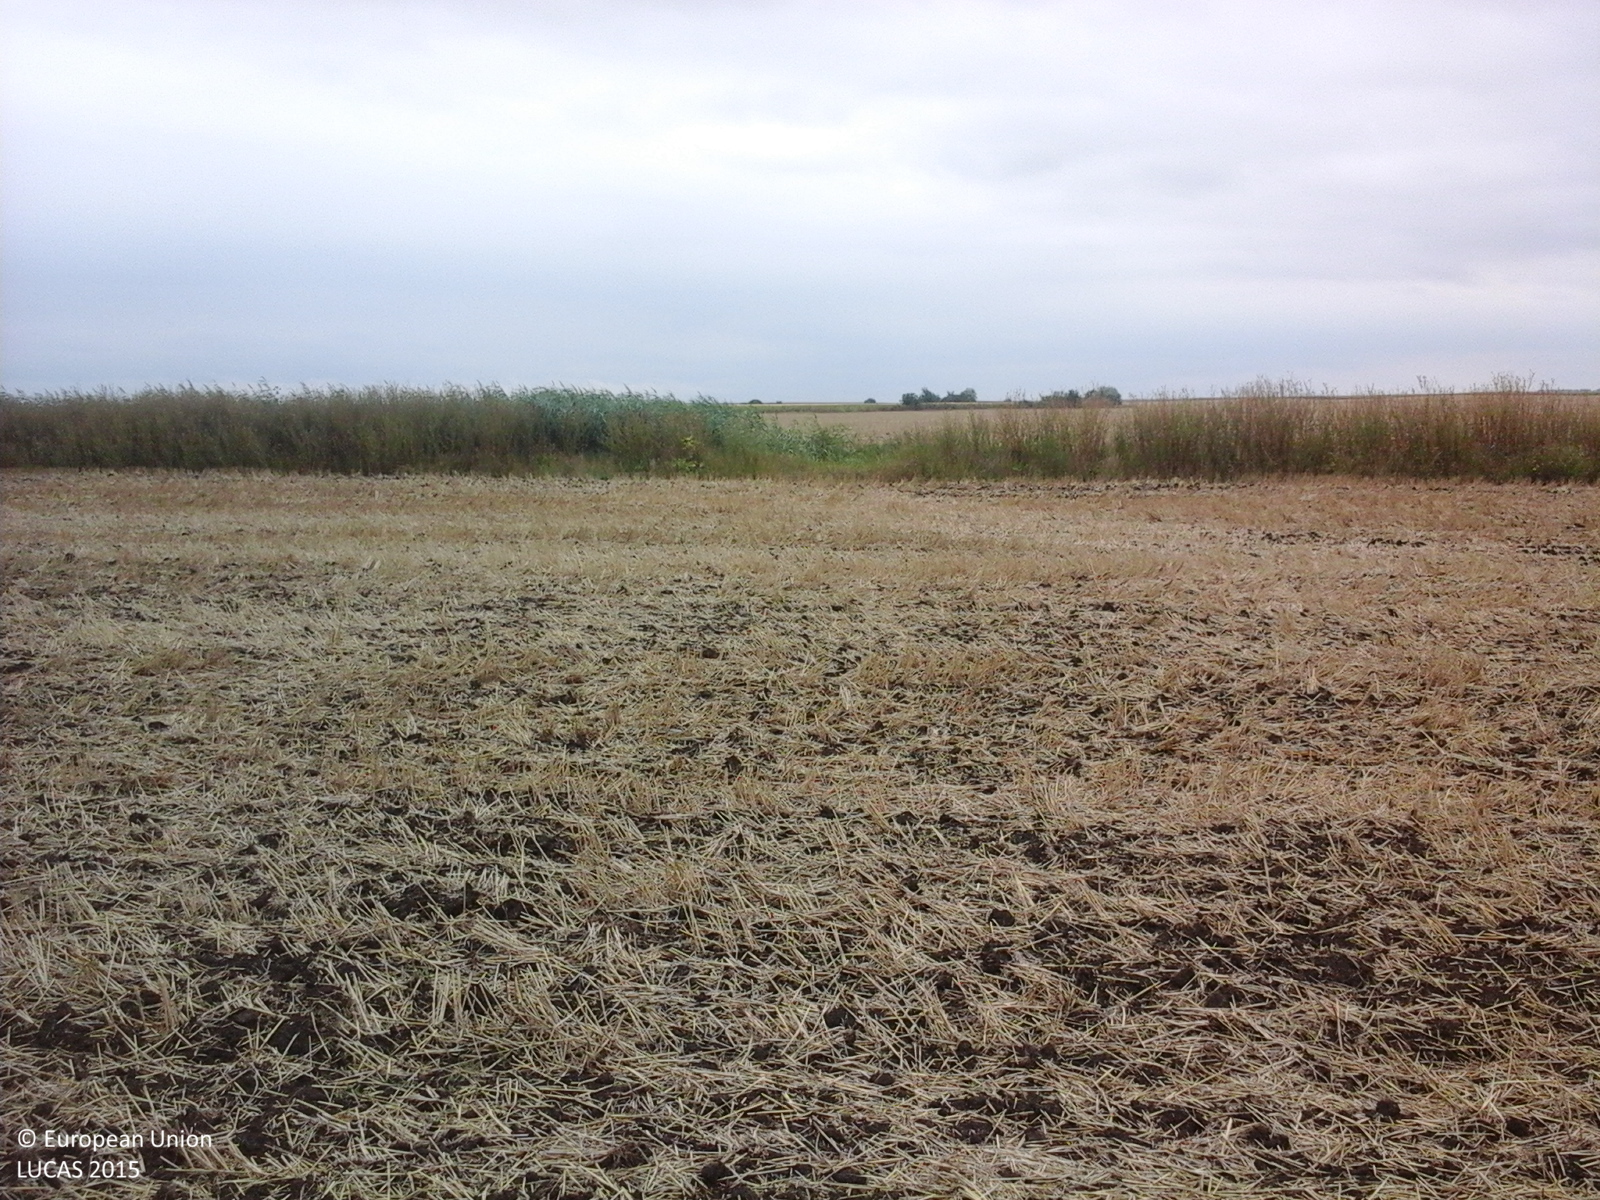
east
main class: Cropland
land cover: Common wheat
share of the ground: 50 - 75 %
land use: Agriculture (excluding fallow land and kitchen gardens)
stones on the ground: < 10 %
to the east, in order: Common wheat; Inland marshes; Ditches and canals; Inland marshes; Common wheat
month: August
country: RO
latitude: 45.9536
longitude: 20.5652
